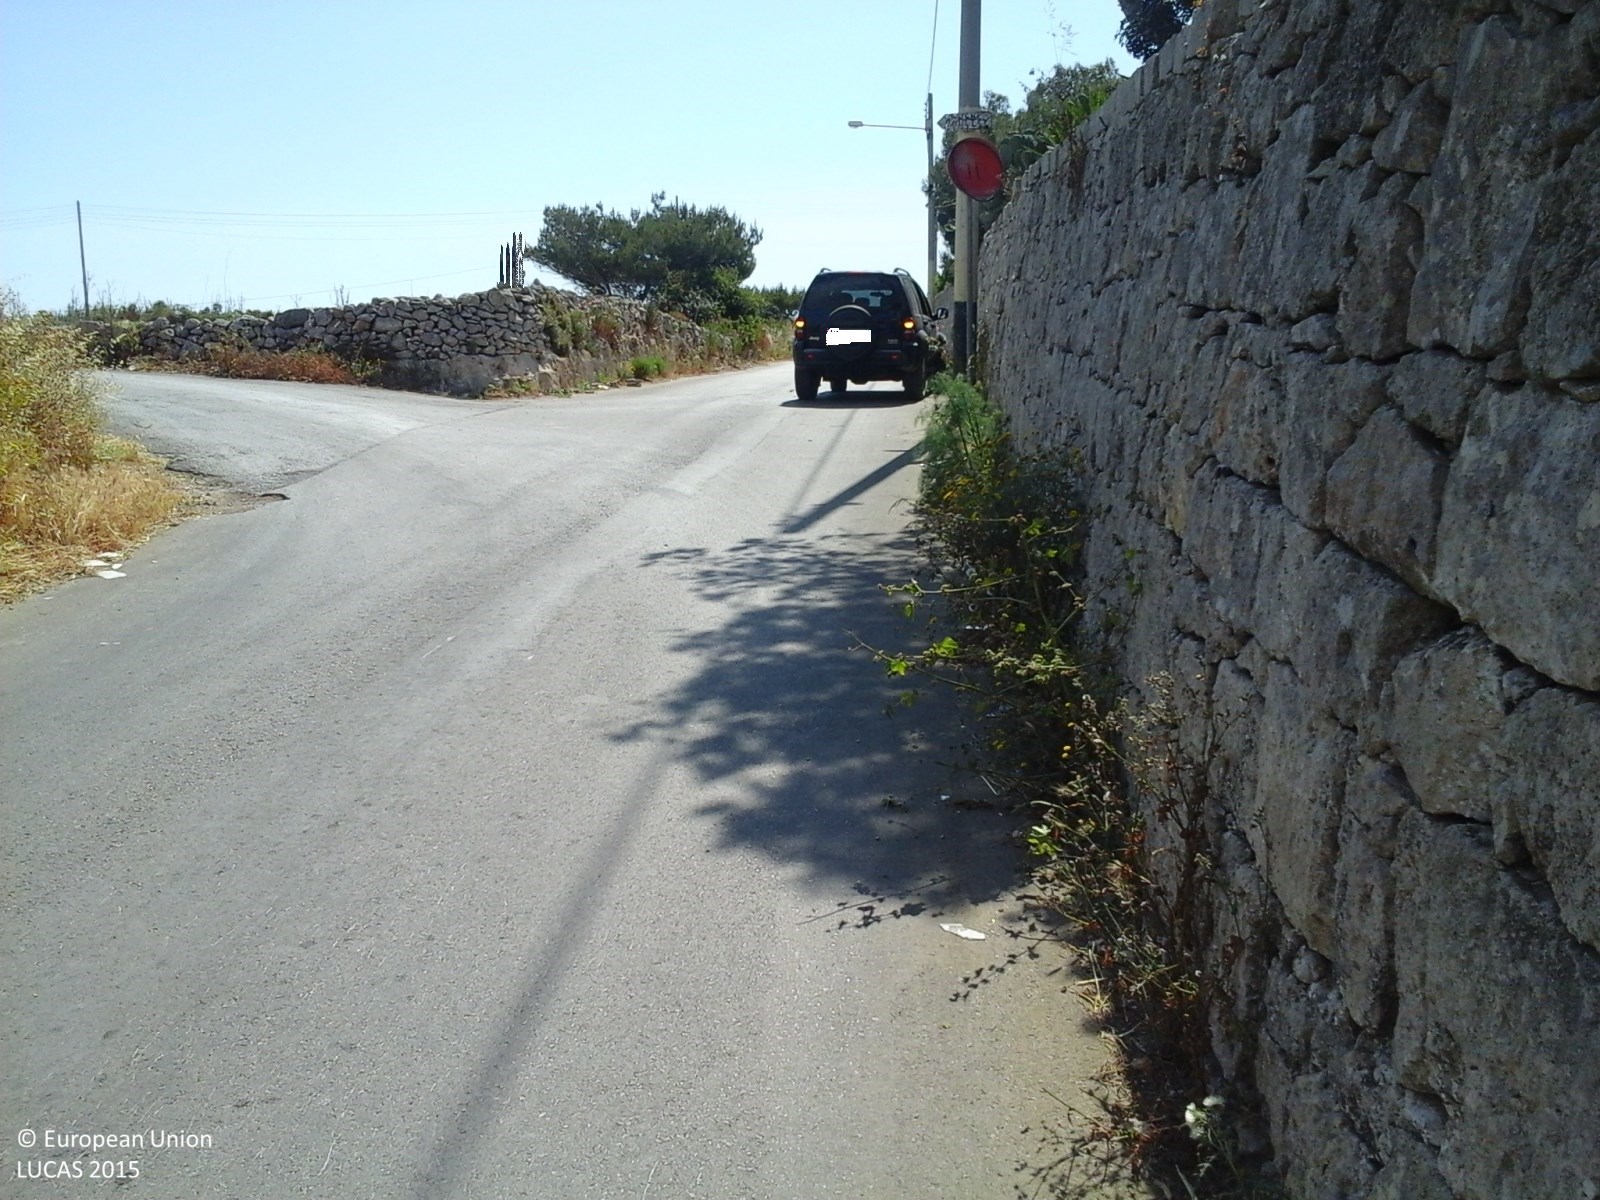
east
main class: Woodland
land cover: Pine dominated coniferous woodland
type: coniferous forest of the mediterranean region
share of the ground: > 75 %
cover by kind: coniferous forest trees 80 %, herbaceous plants 20 %
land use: Residential
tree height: > 5 m
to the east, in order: Pine dominated coniferous woodland; Artificial constructions in urban areas; Dry stone walls; Electric lines; Paved roads, cycling and walking lanes; Dry stone walls; Grassland with sparse tree/shrub cover; Durum wheat; Electric lines; Spontaneously vegetated surfaces; Tracks; Dry stone walls; Grass margins; Single bushes/trees; Paved roads, cycling and walking lanes; Lines of trees
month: May
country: MT
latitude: 35.8623
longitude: 14.3999
